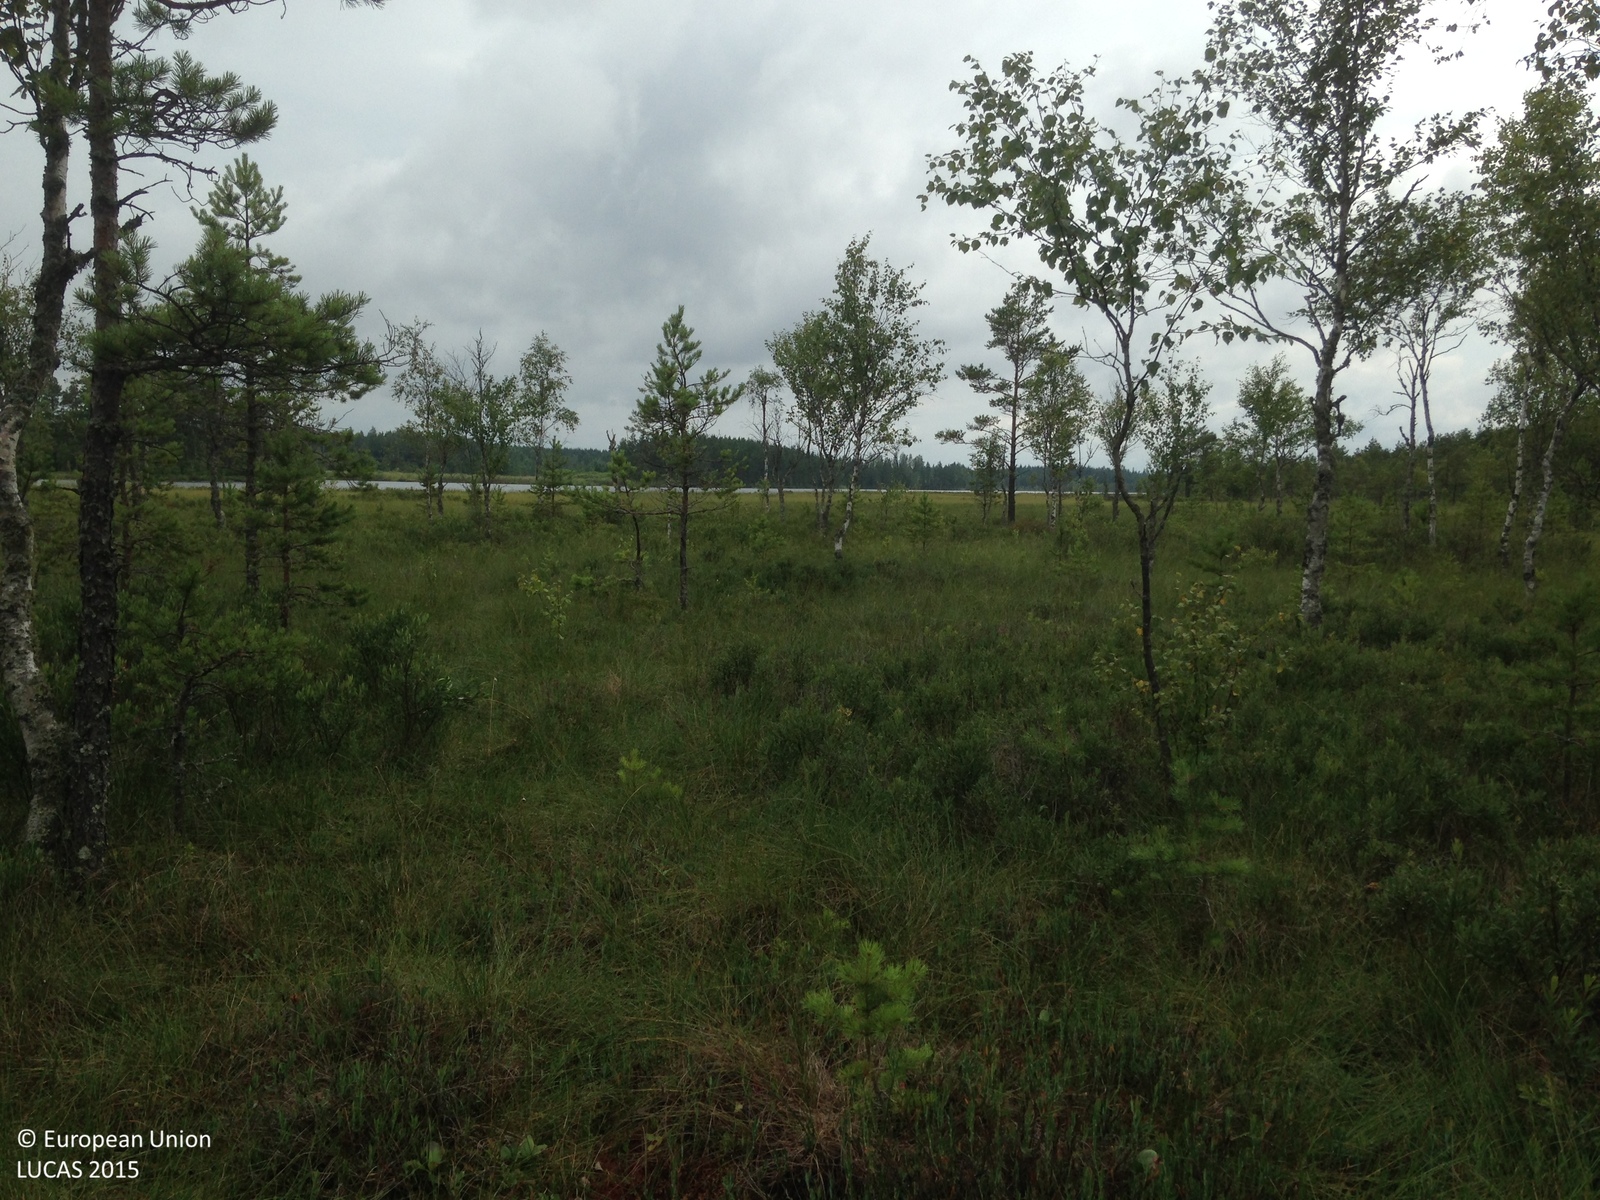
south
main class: Woodland
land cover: Pine dominated mixed woodland
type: boreal forest
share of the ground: 25 - 50 %
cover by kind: lichens and mosses 30 %, shrubs 25 %, coniferous forest trees 20 %, broadleaved forest trees 15 %, herbaceous plants 10 %
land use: Semi-natural and natural areas not in use
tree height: < 5 m
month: July
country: SE
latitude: 59.0584
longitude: 14.6478
